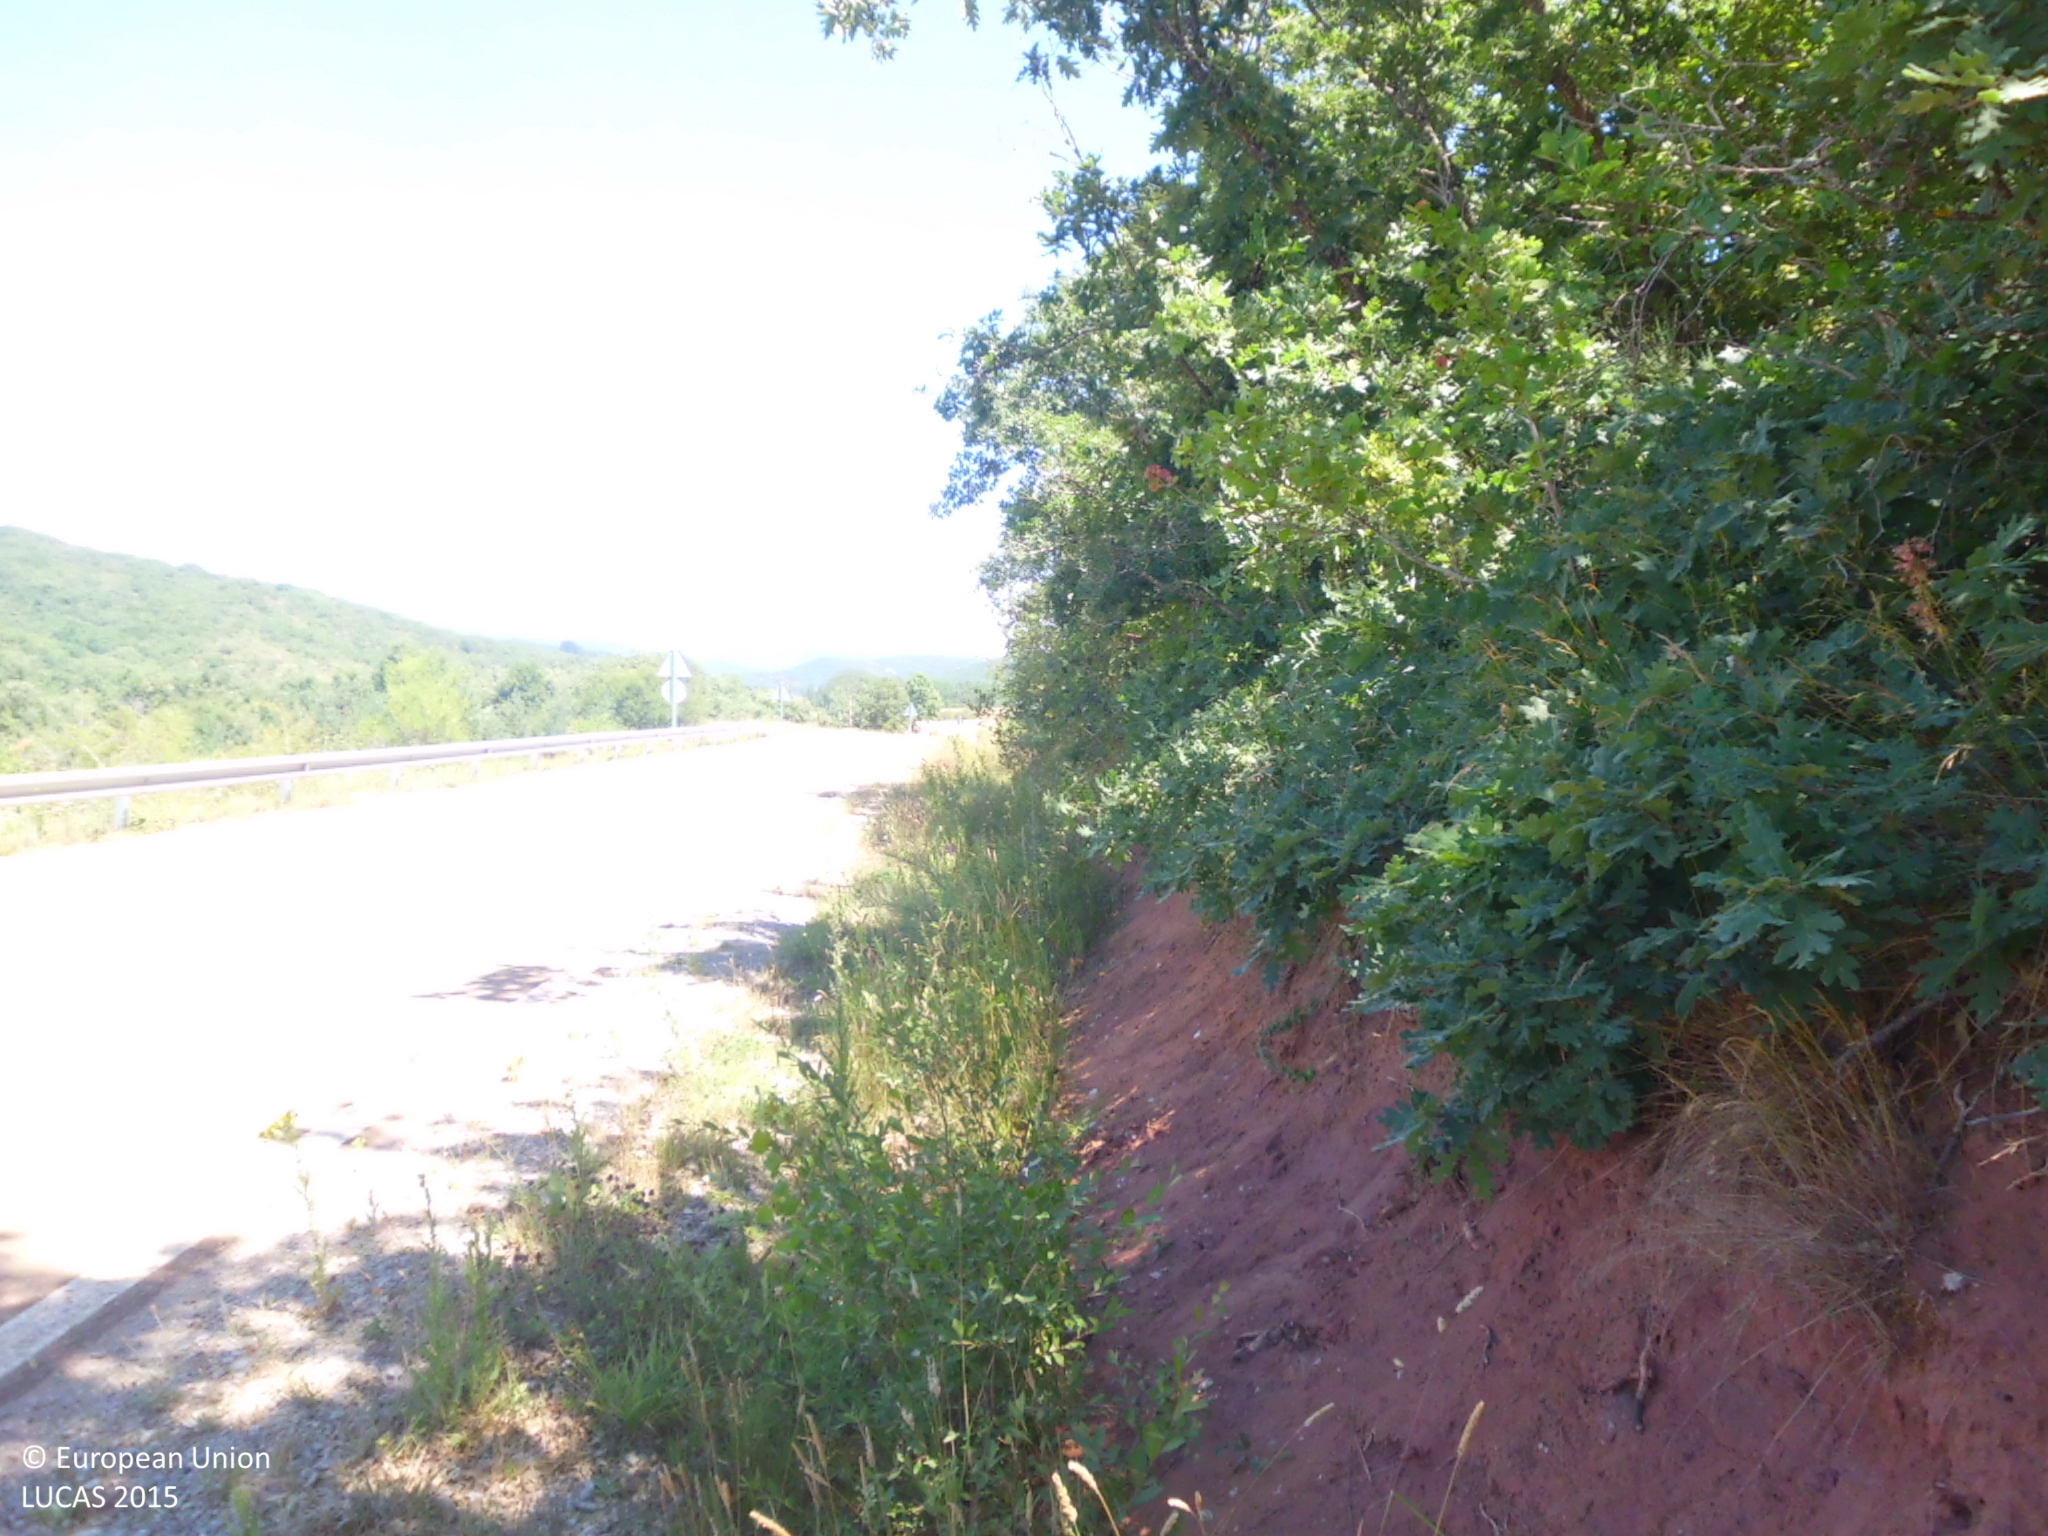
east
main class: Woodland
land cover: Broadleaved woodland
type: mesophytic deciduous forest
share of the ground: 50 - 75 %
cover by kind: broadleaved forest trees 50 %, herbaceous plants 20 %, consolidated bare surface 20 %, shrubs 10 %
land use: Semi-natural and natural areas not in use
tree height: > 5 m
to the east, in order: Broadleaved woodland; Paved roads, cycling and walking lanes; Grassland with sparse tree/shrub cover; Paved roads, cycling and walking lanes
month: July
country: ES
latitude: 42.7974
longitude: -4.0957
